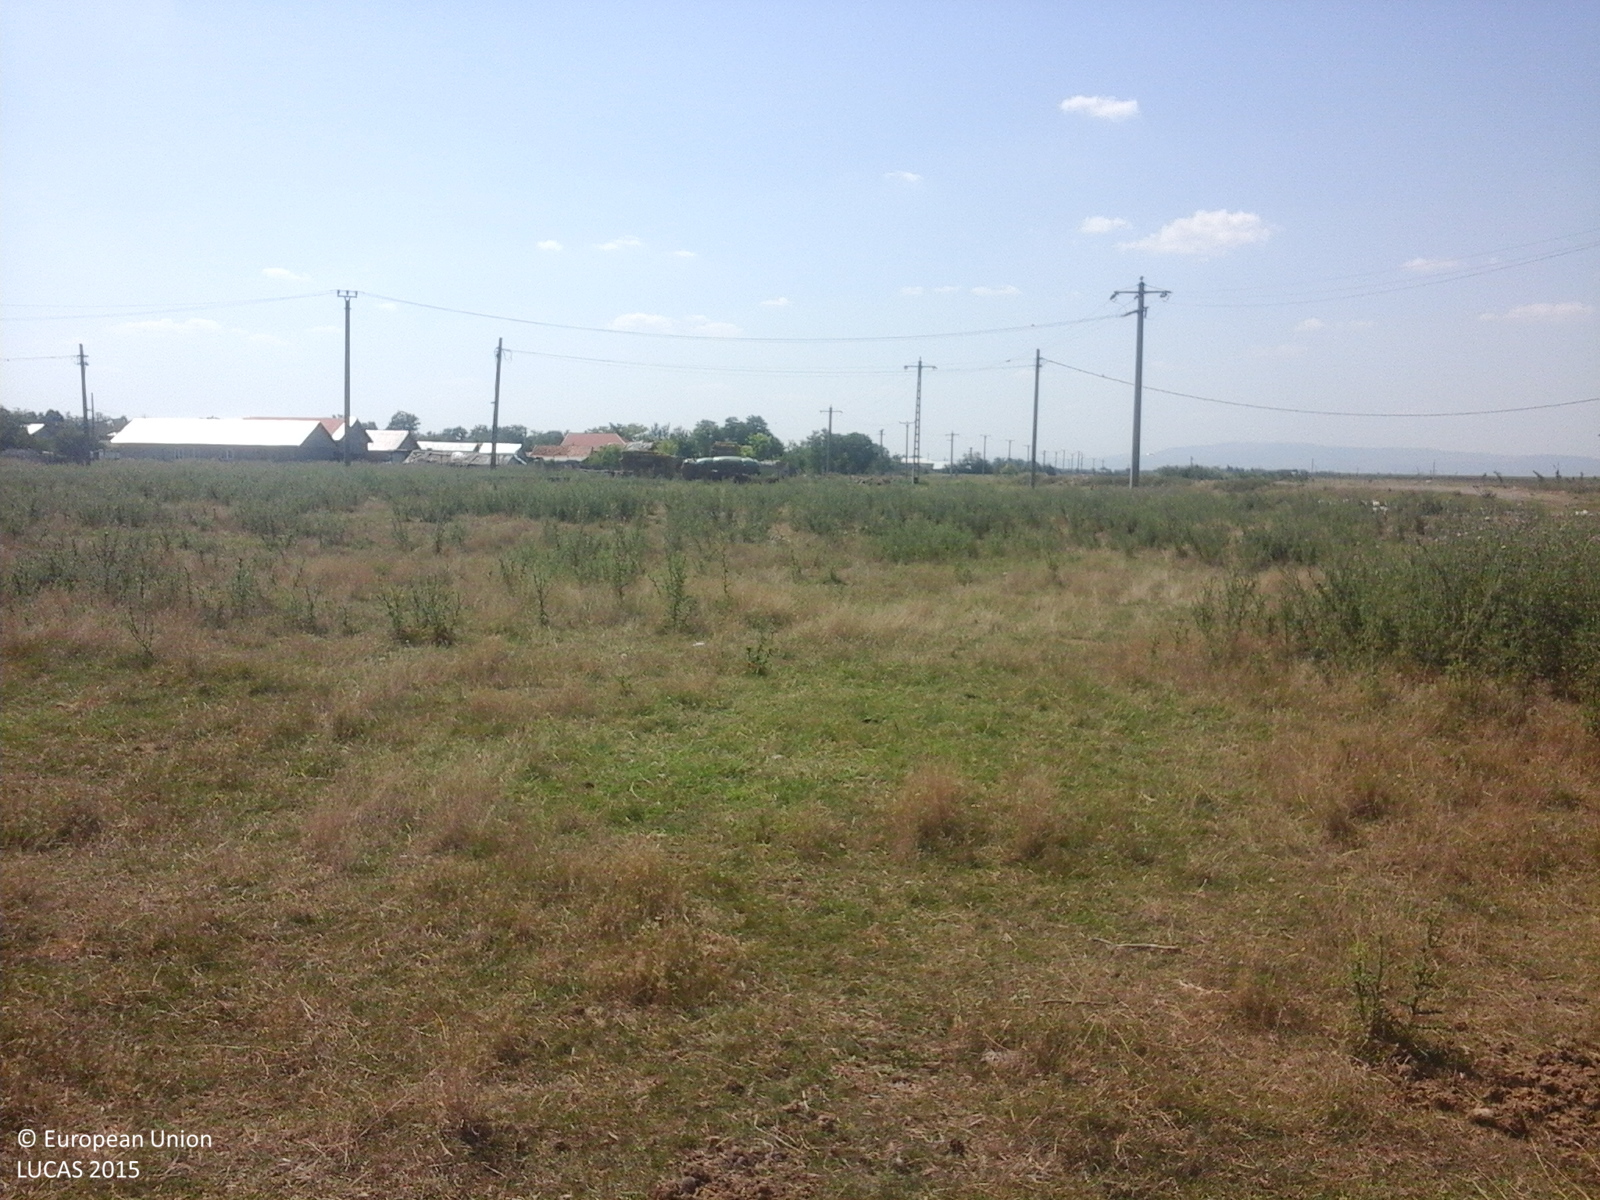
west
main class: Grassland
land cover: Spontaneously vegetated surfaces
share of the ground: > 75 %
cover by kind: herbaceous plants 100 %
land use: Agriculture (excluding fallow land and kitchen gardens)
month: July
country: RO
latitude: 44.9999
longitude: 26.8630
